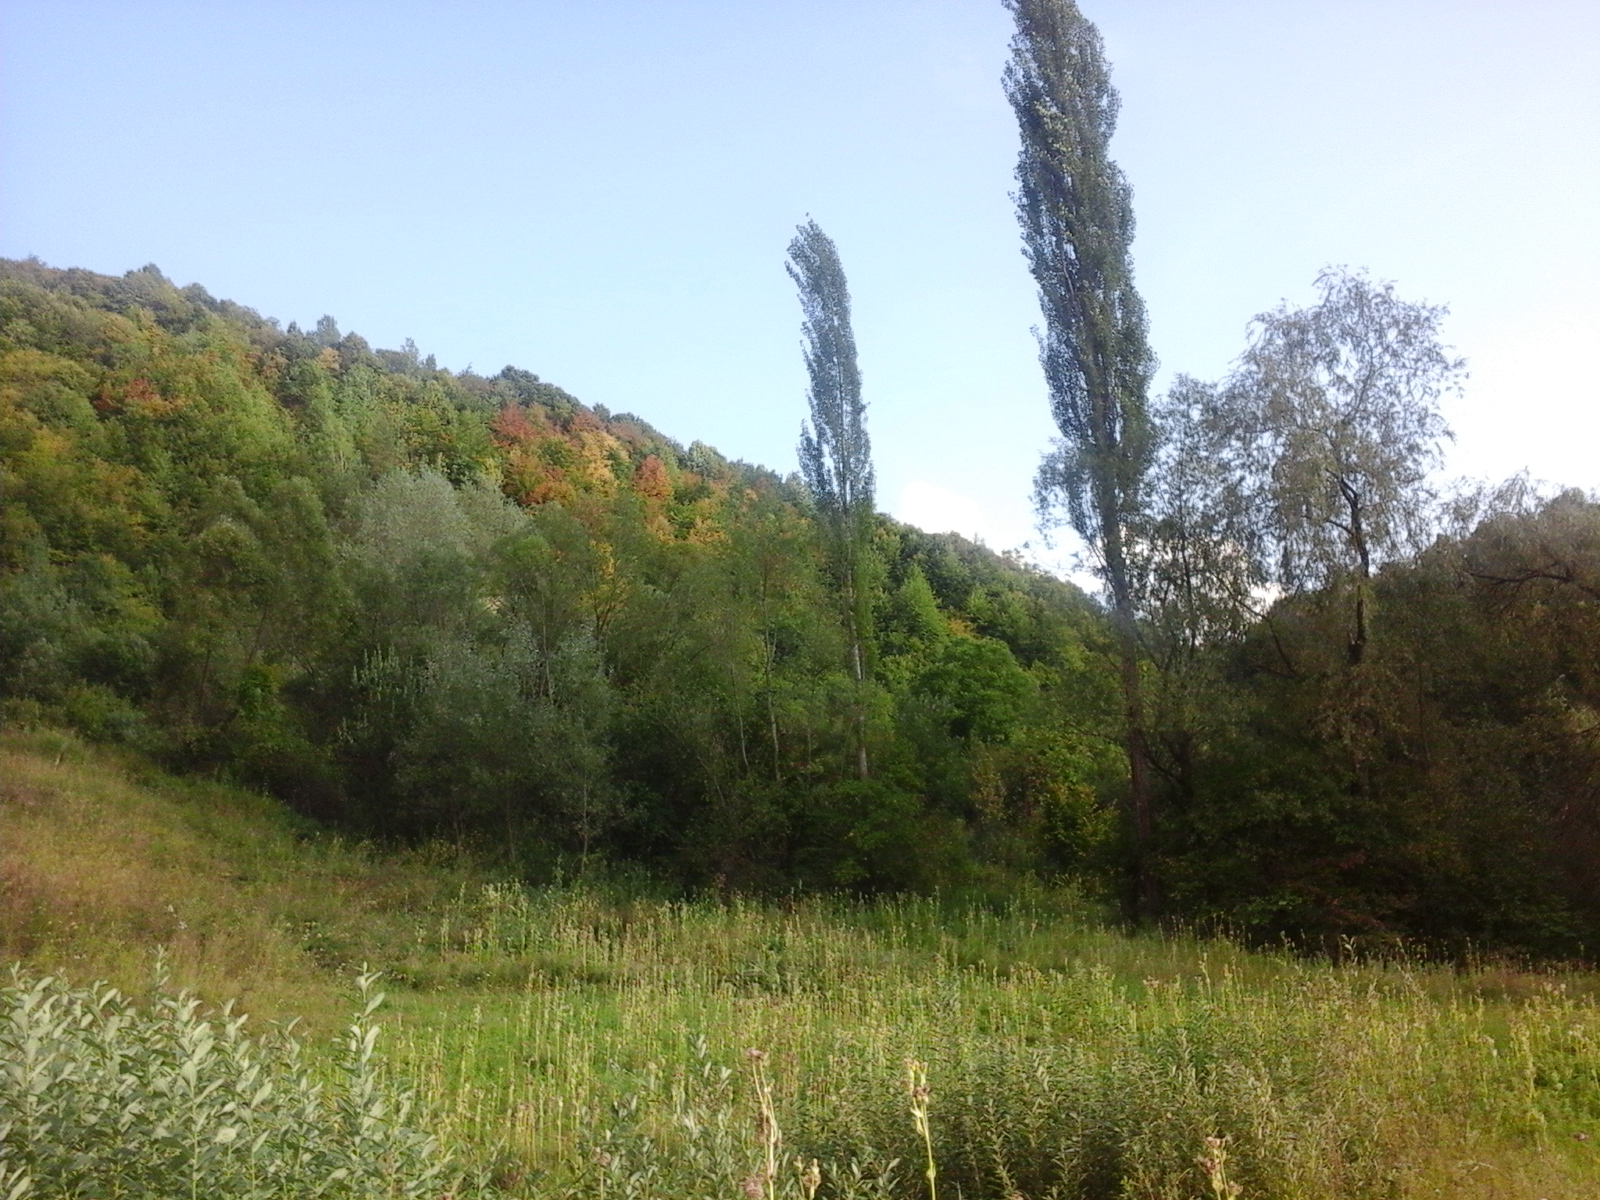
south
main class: Grassland
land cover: Grassland with sparse tree/shrub cover
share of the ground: > 75 %
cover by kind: herbaceous plants 95 %, broadleaved forest trees 5 %
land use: Agriculture (excluding fallow land and kitchen gardens)
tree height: > 5 m
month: September
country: RO
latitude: 47.7497
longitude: 24.2416
